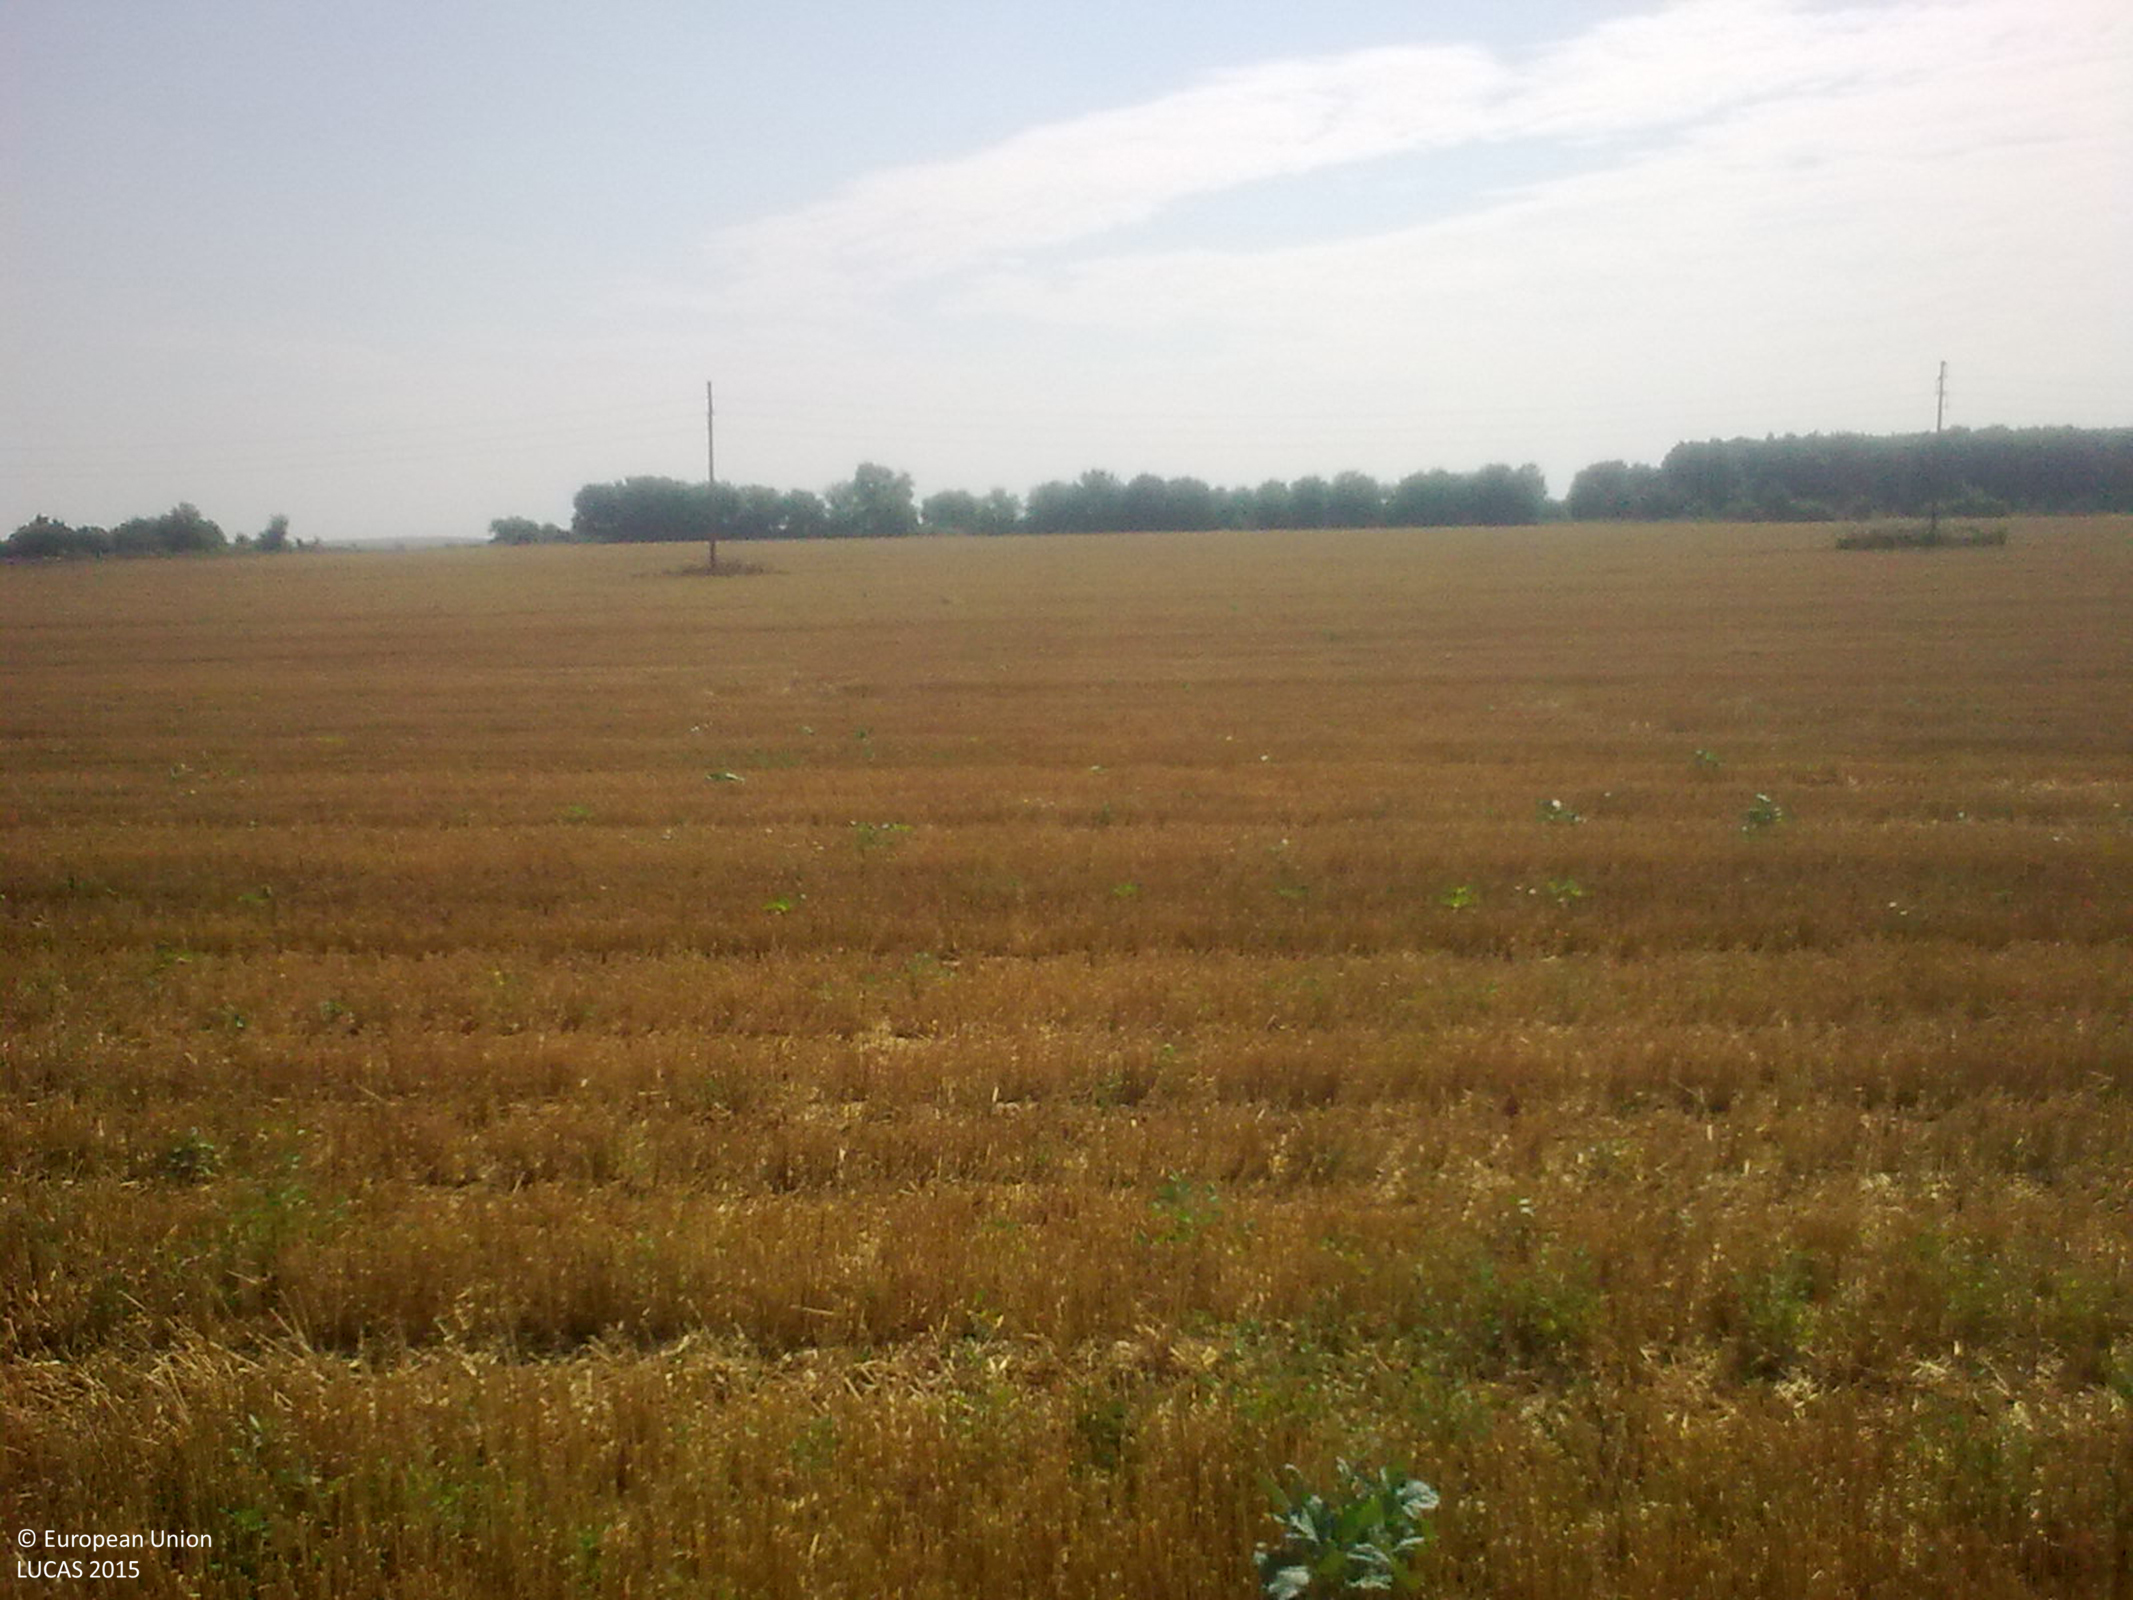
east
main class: Cropland
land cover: Common wheat
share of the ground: 50 - 75 %
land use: Agriculture (excluding fallow land and kitchen gardens)
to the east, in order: Common wheat; Electric lines; Common wheat
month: July
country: BG
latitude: 43.7870
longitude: 26.2946
